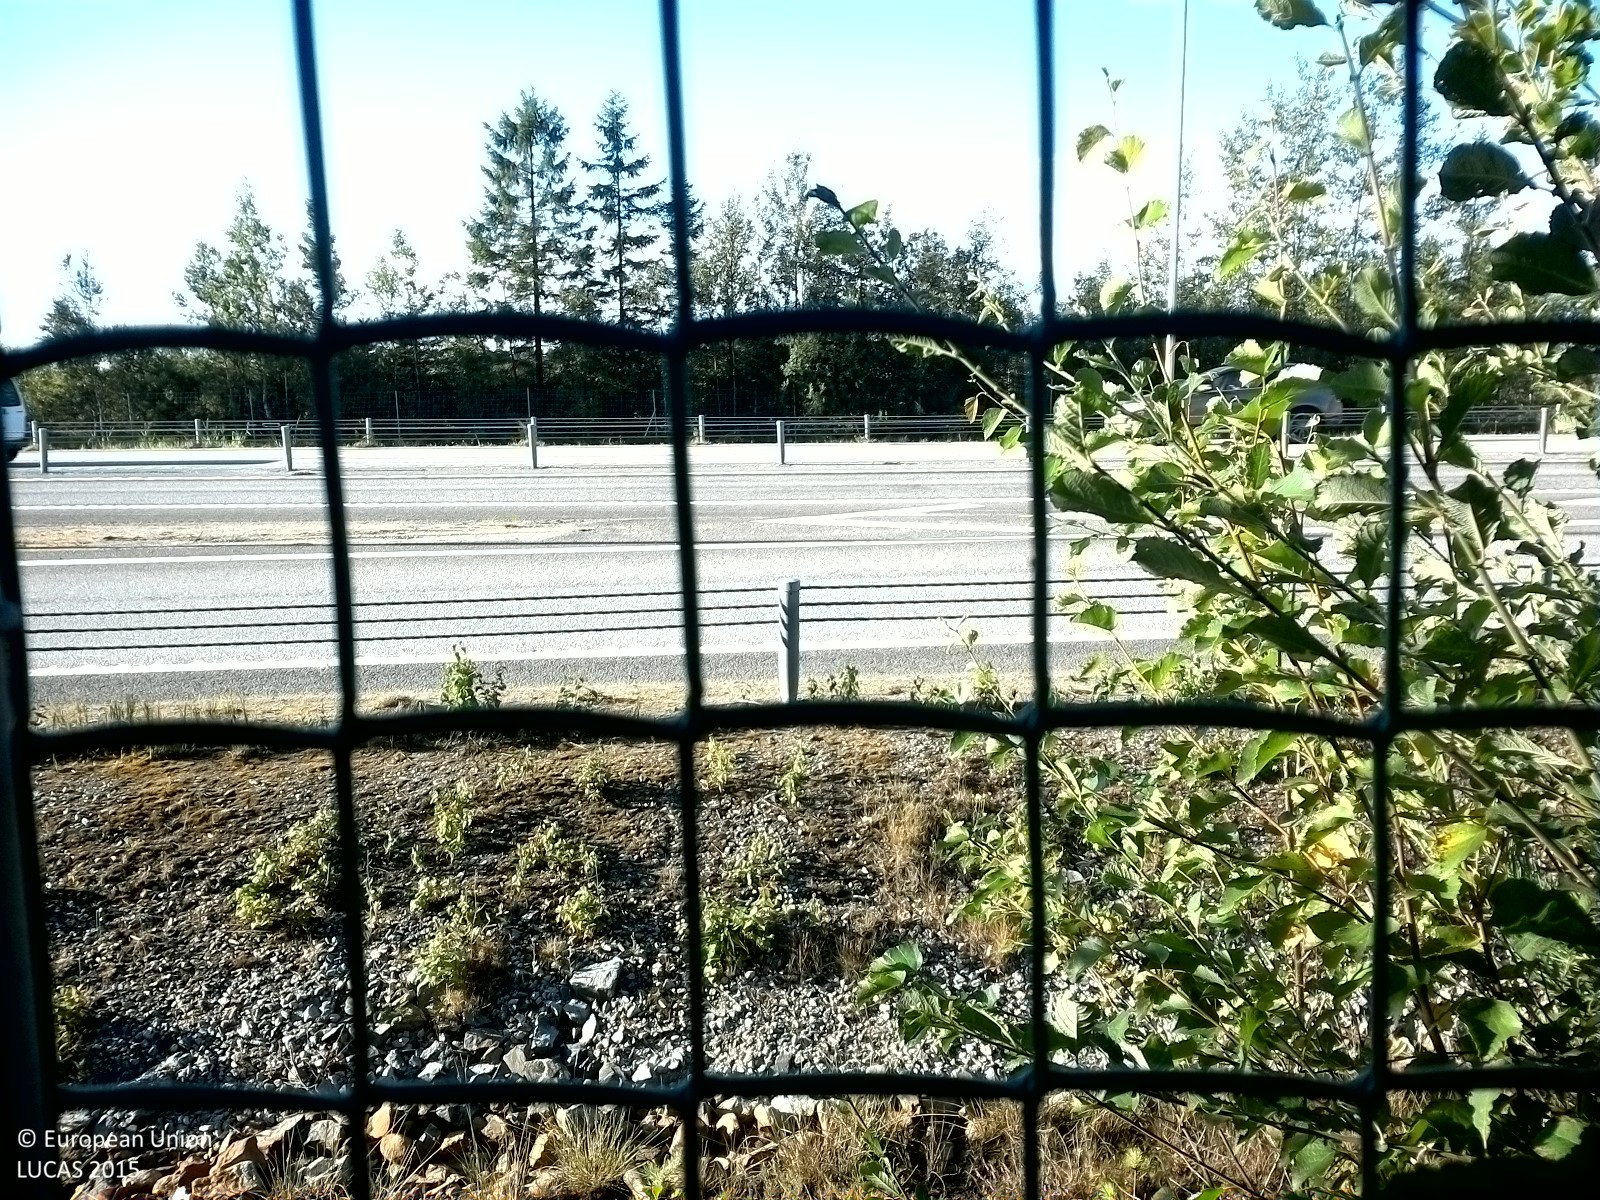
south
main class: Woodland
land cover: Broadleaved woodland
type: hemiboreal forest and nemoral coniferous forest and mixed broadleaved-coniferous forest
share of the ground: 50 - 75 %
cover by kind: broadleaved forest trees 70 %, herbaceous plants 30 %
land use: Semi-natural and natural areas not in use
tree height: < 5 m
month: August
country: SE
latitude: 59.2397
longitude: 15.1278
